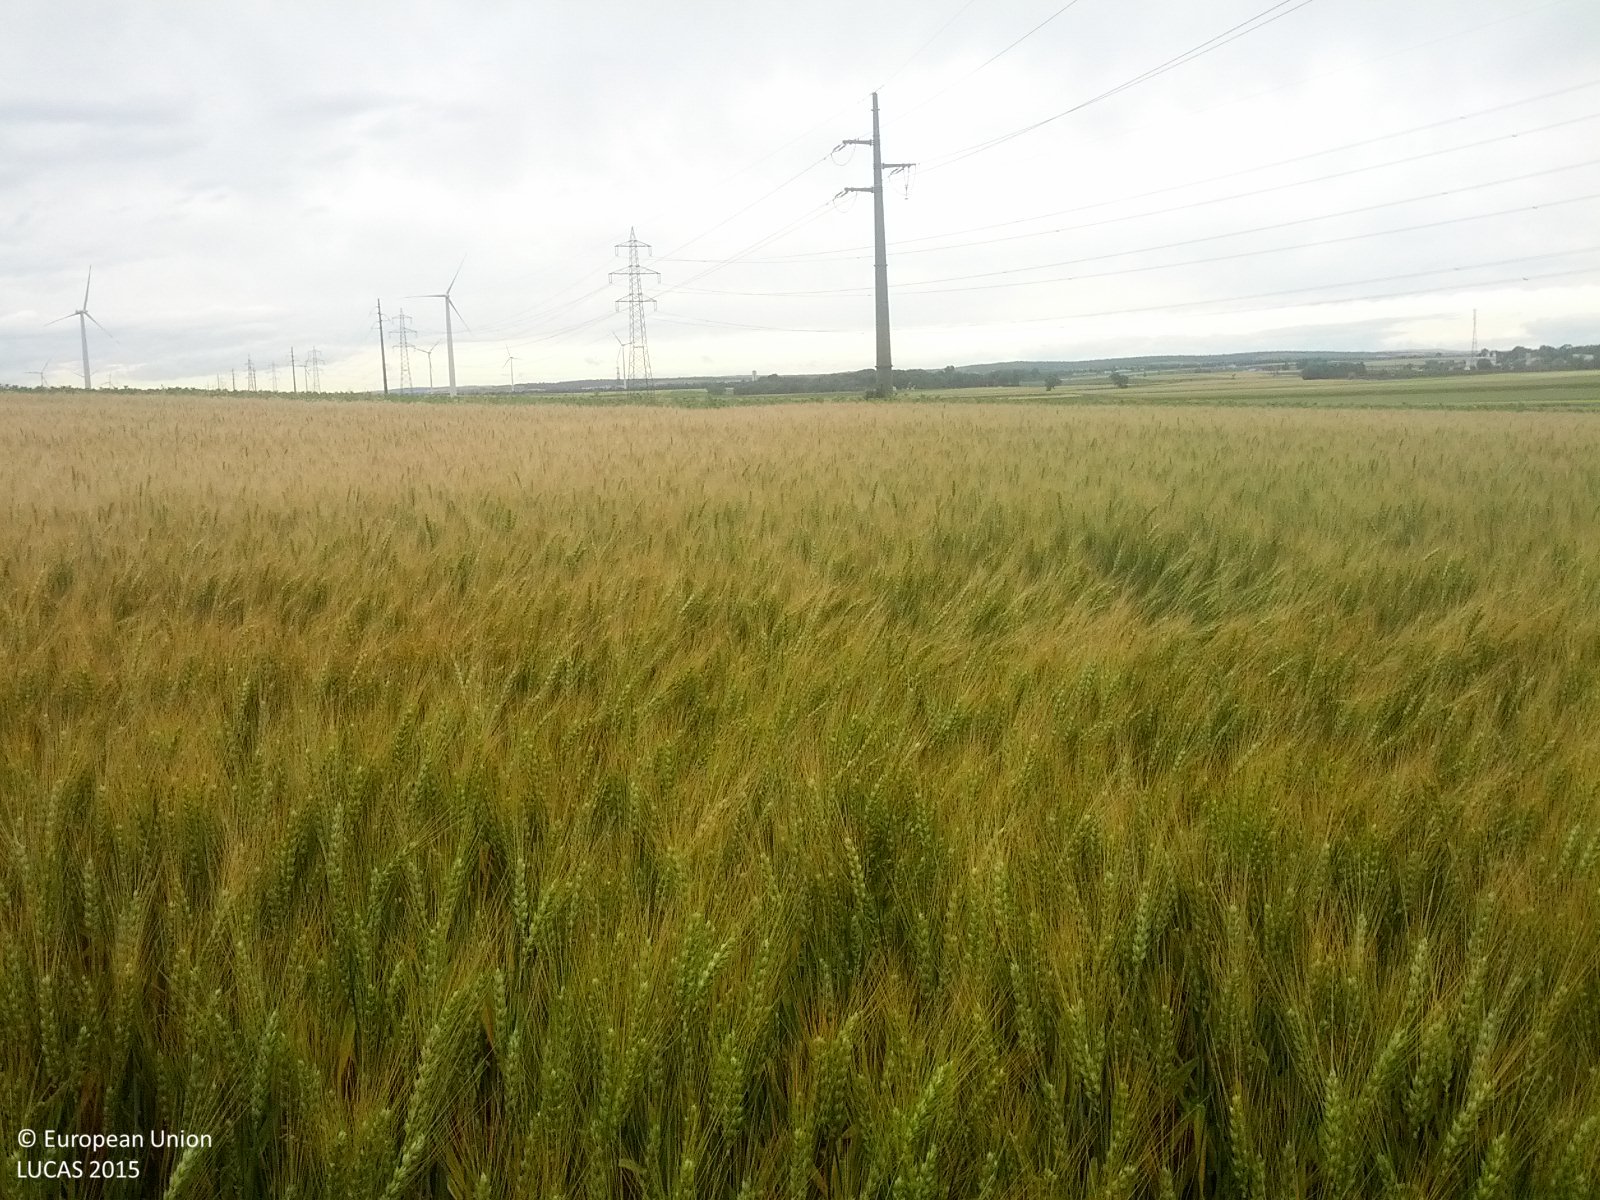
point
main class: Cropland
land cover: Common wheat
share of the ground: > 75 %
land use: Agriculture (excluding fallow land and kitchen gardens)
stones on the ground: 25 - 50 %
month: June
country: AT
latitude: 48.3439
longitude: 16.7123
